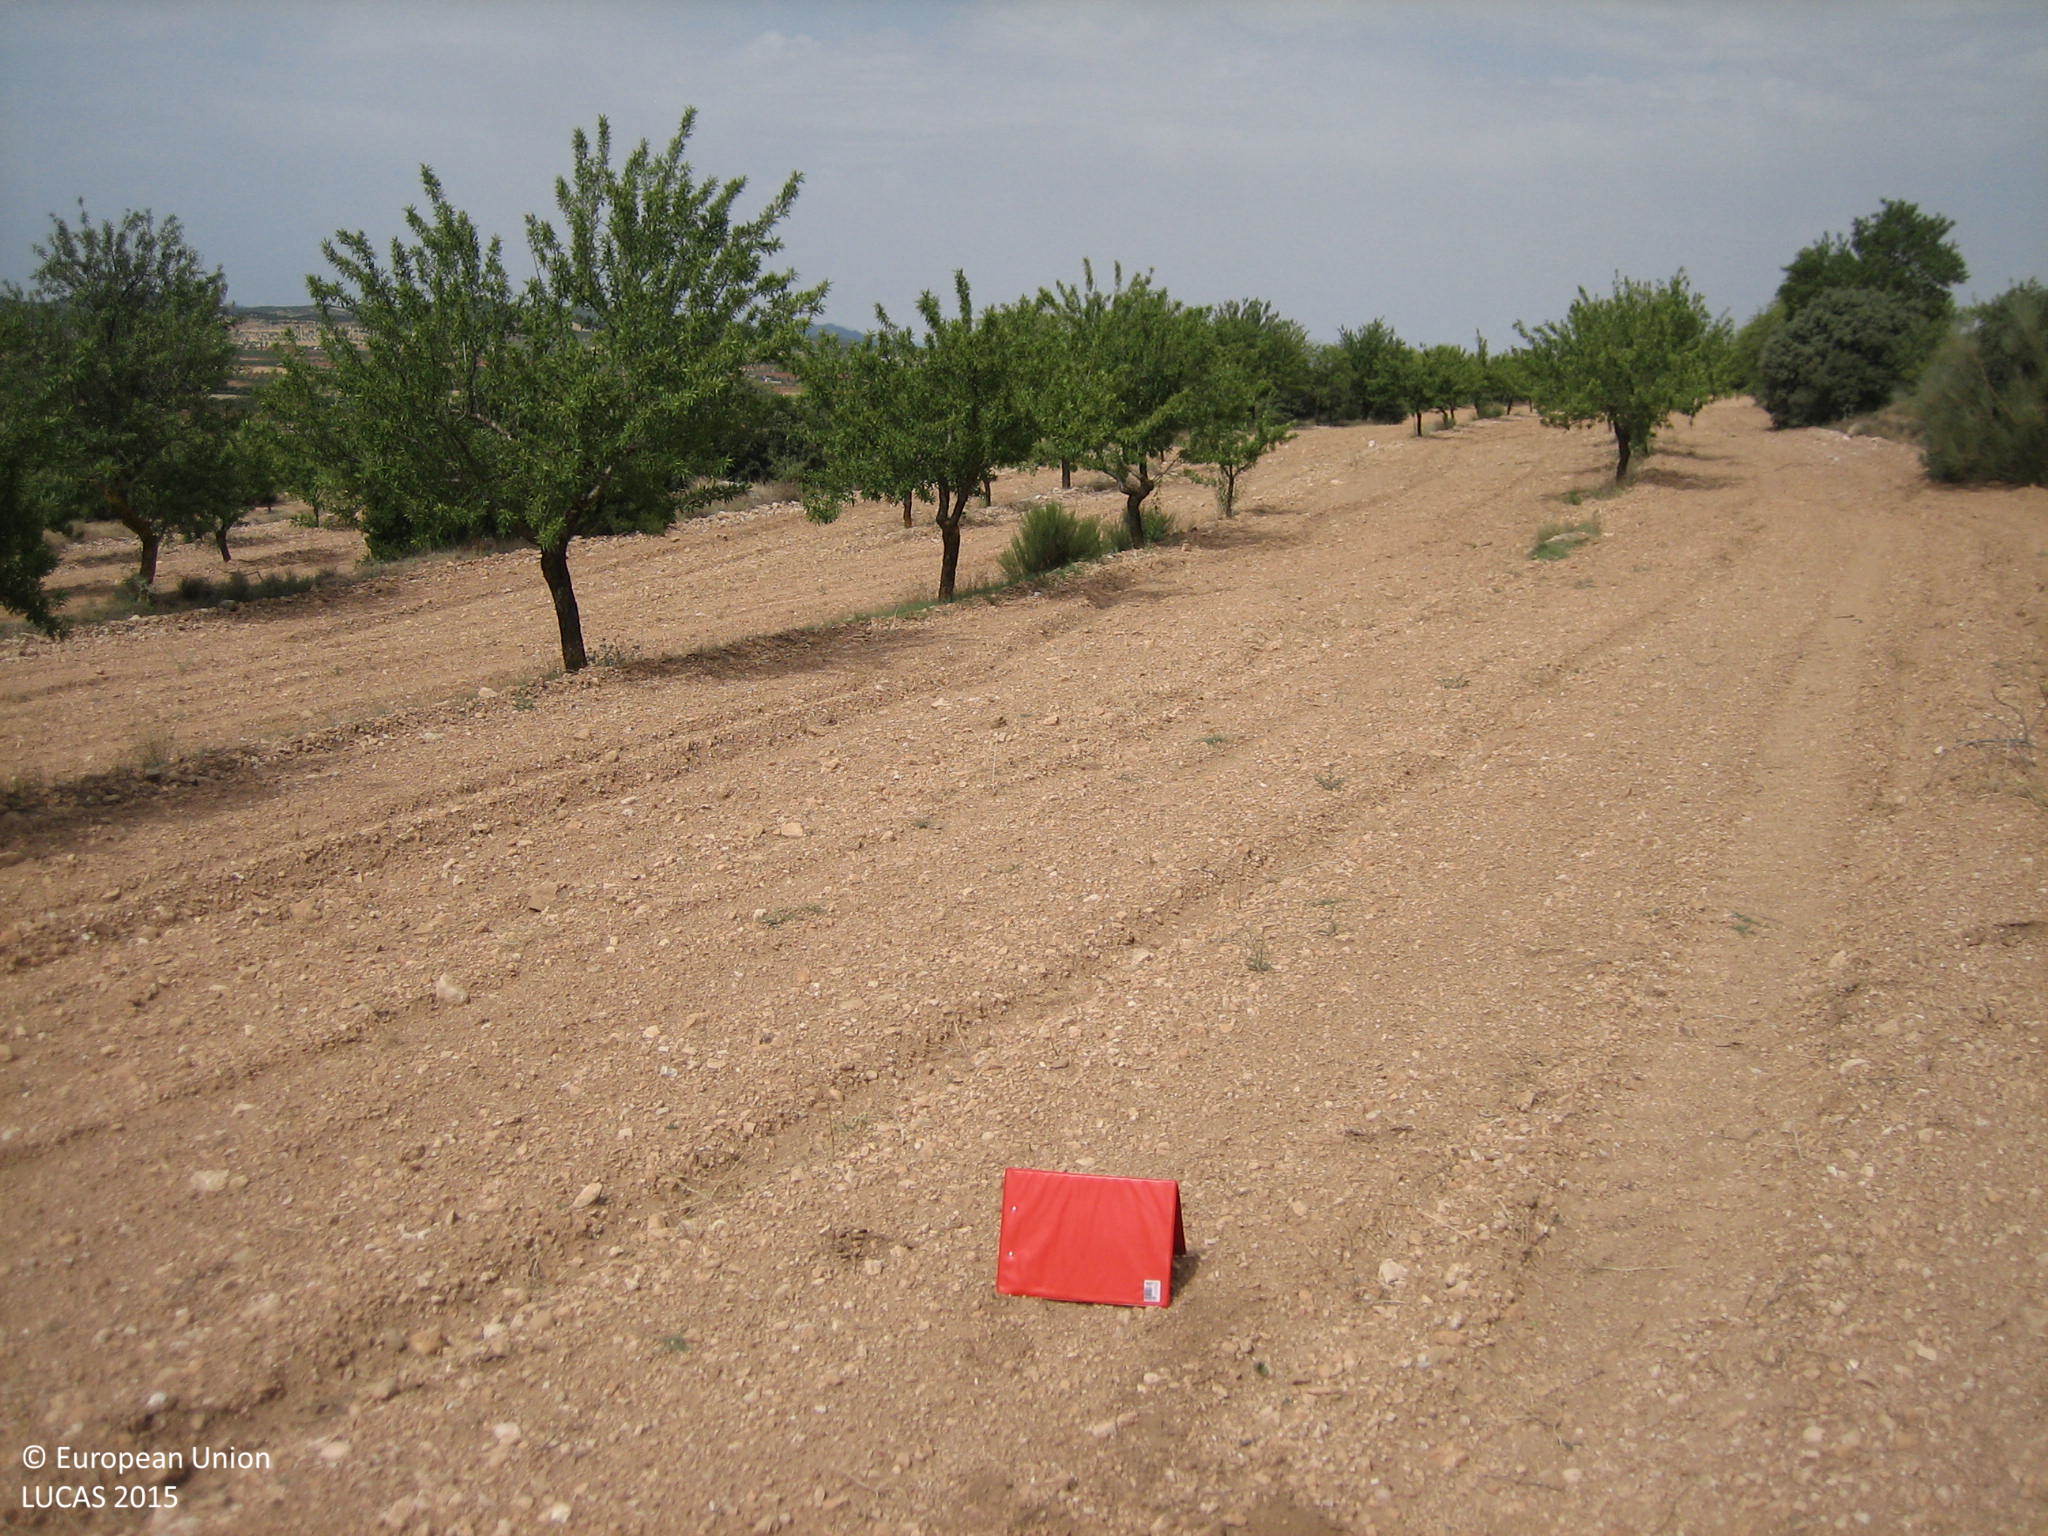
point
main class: Cropland
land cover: Nuts trees
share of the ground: < 10 %
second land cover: Other bare soil
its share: > 75 %
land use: Agriculture (excluding fallow land and kitchen gardens)
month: July
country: ES
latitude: 37.6027
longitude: -2.3206
